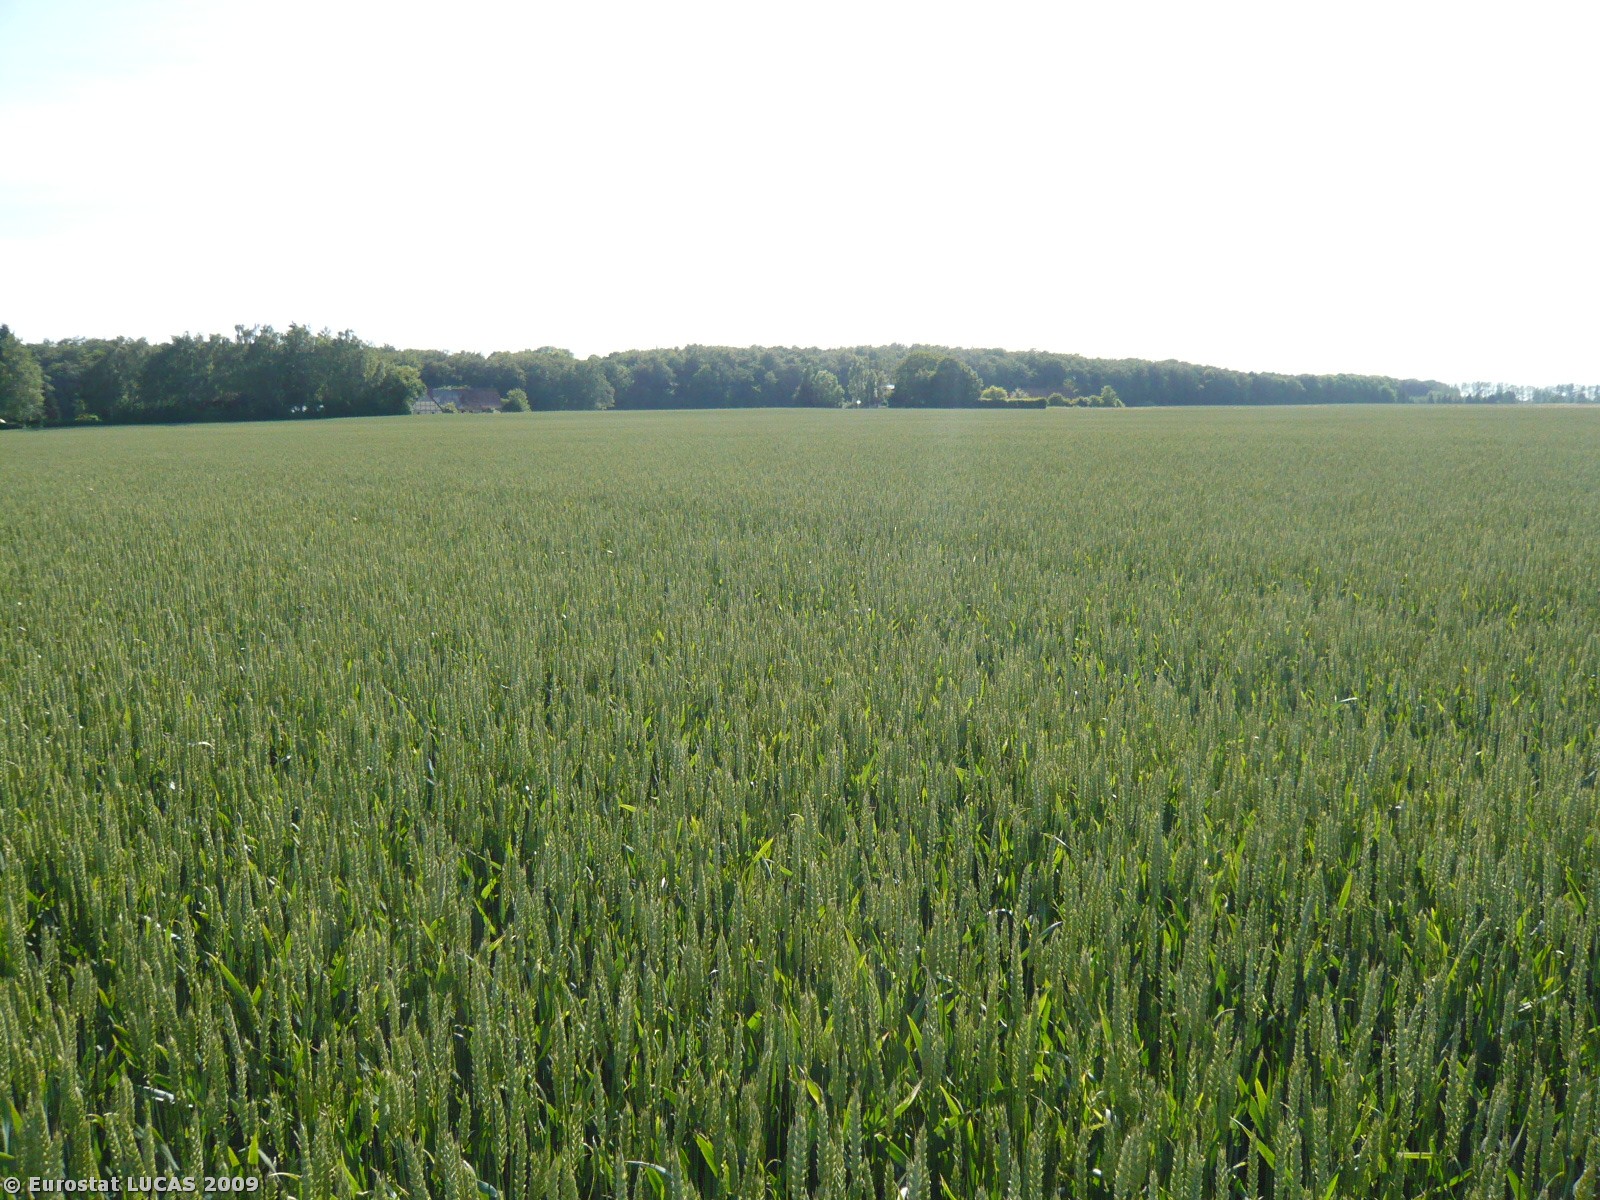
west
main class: Cropland
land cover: Common wheat
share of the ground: > 75 %
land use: Agriculture (excluding fallow land and kitchen gardens)
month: June
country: DK
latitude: 54.7964
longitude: 11.3523
